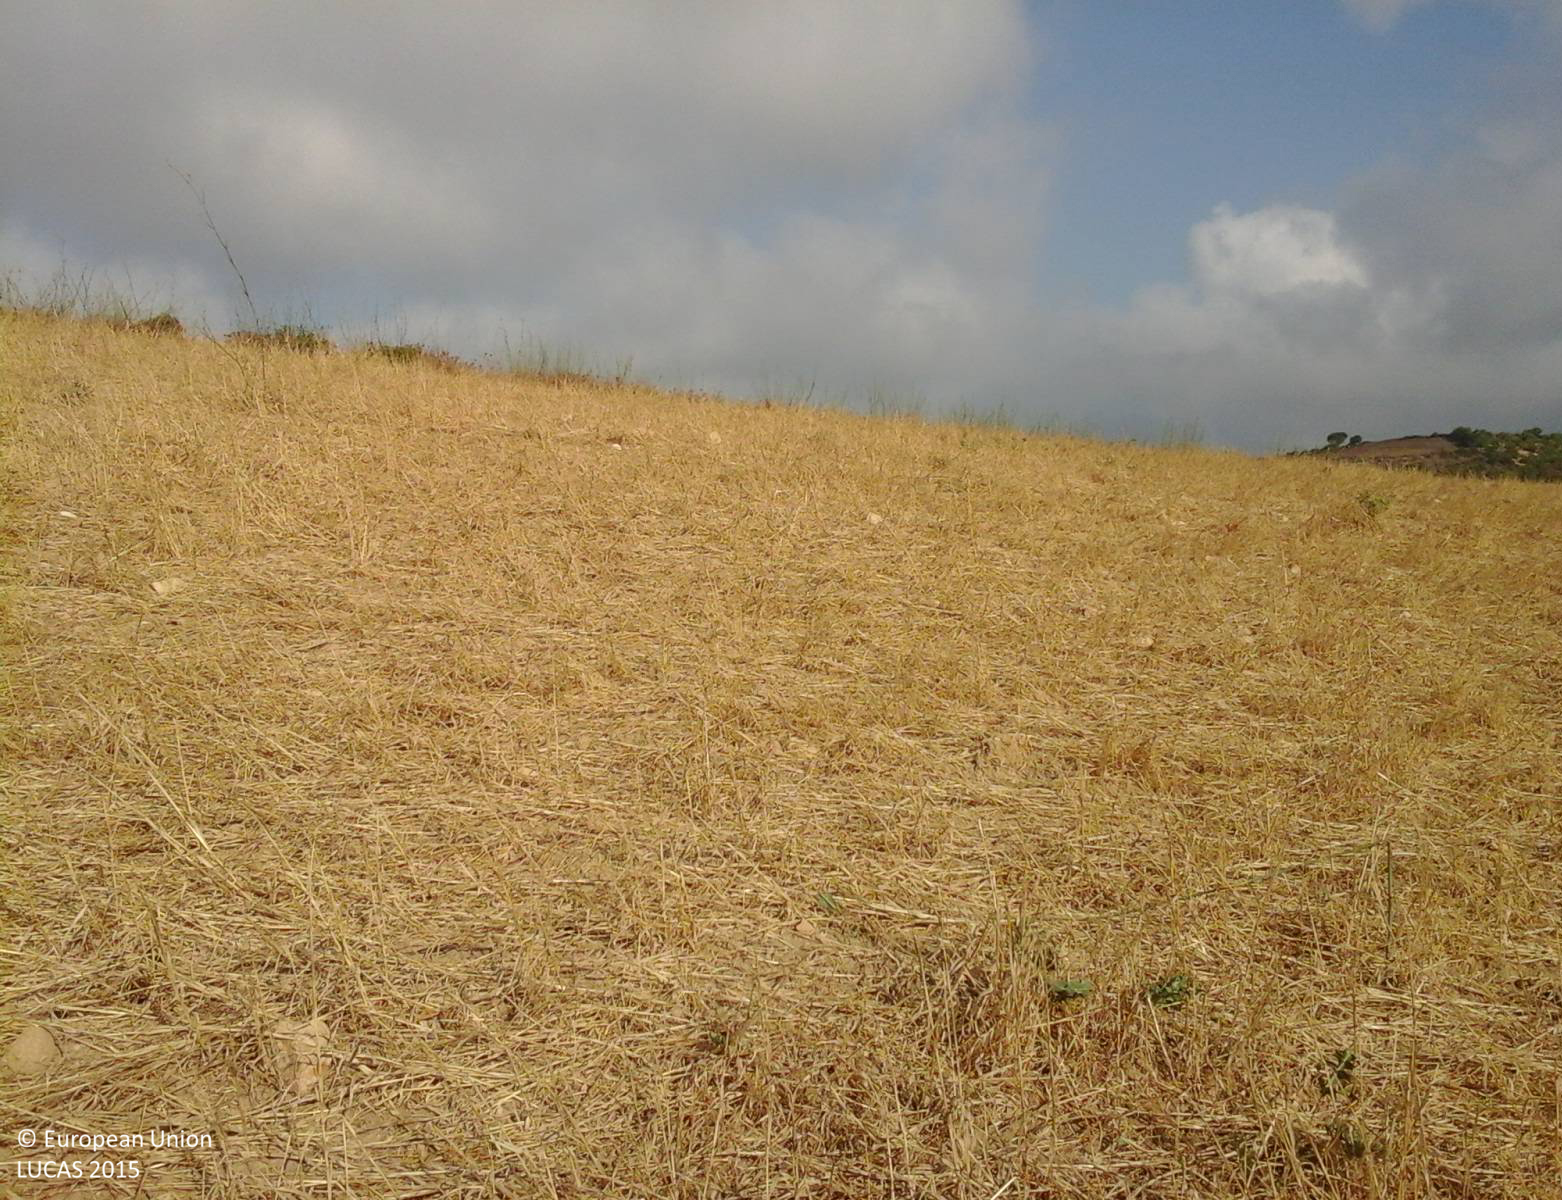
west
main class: Cropland
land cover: Mixed cereals for fodder
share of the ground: > 75 %
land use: Agriculture (excluding fallow land and kitchen gardens)
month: July
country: IT
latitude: 39.6089
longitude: 8.8768
